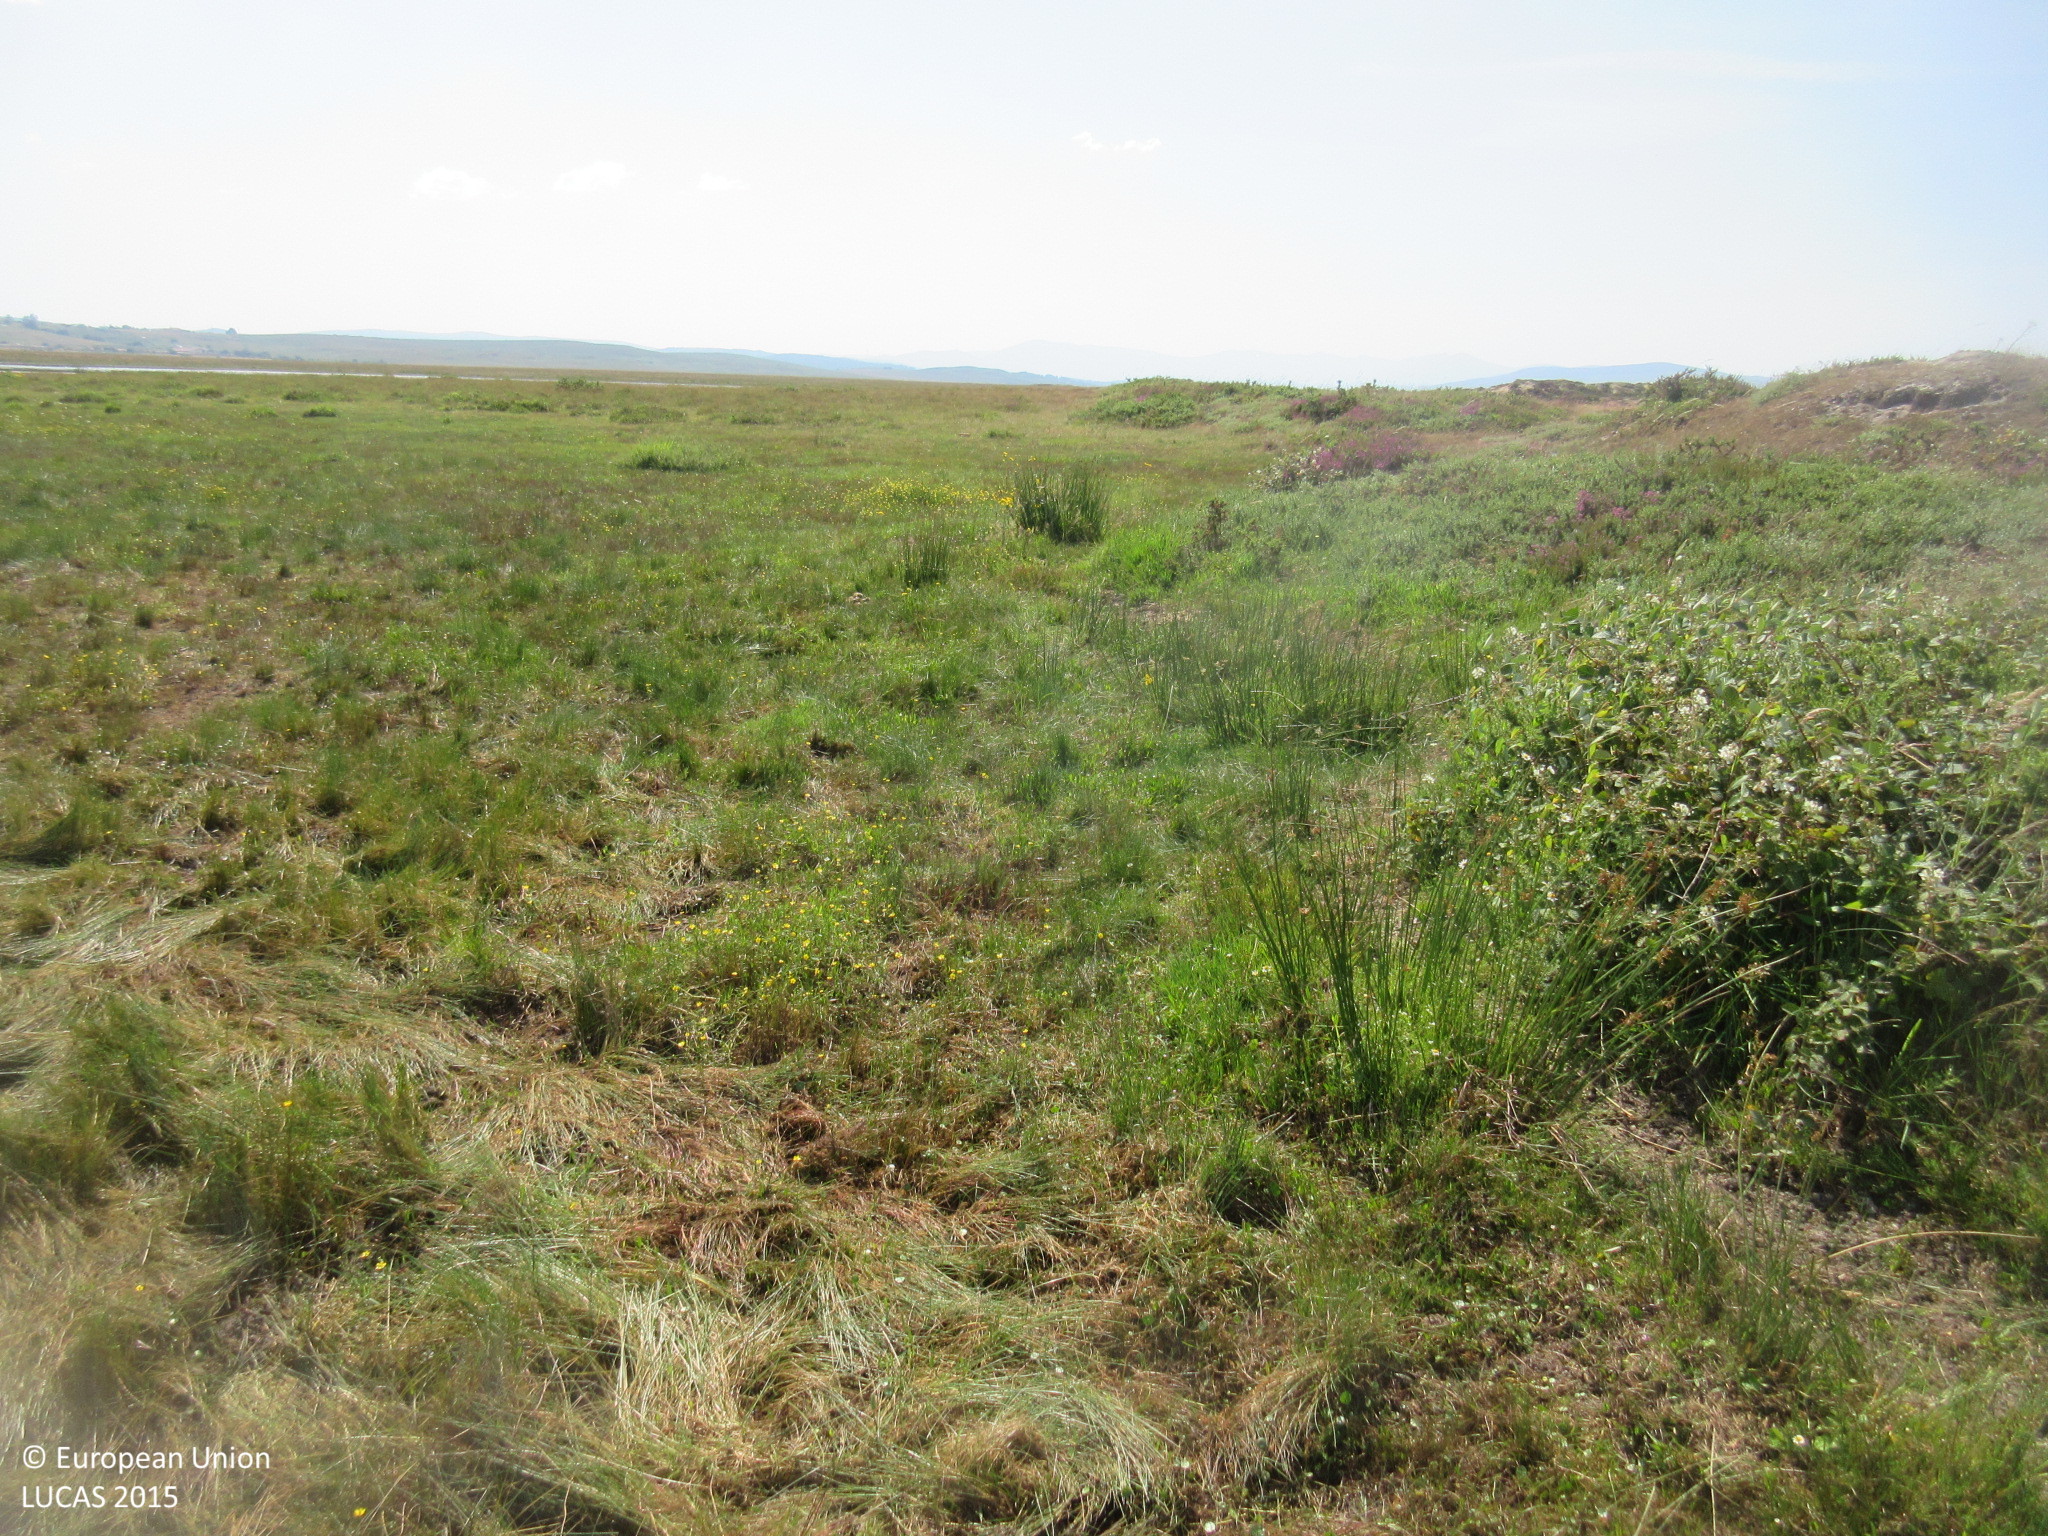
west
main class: Grassland
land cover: Grassland without tree/shrub cover
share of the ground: > 75 %
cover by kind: herbaceous plants 100 %
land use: Agriculture (excluding fallow land and kitchen gardens)
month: July
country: ES
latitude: 42.9935
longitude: -3.8688
